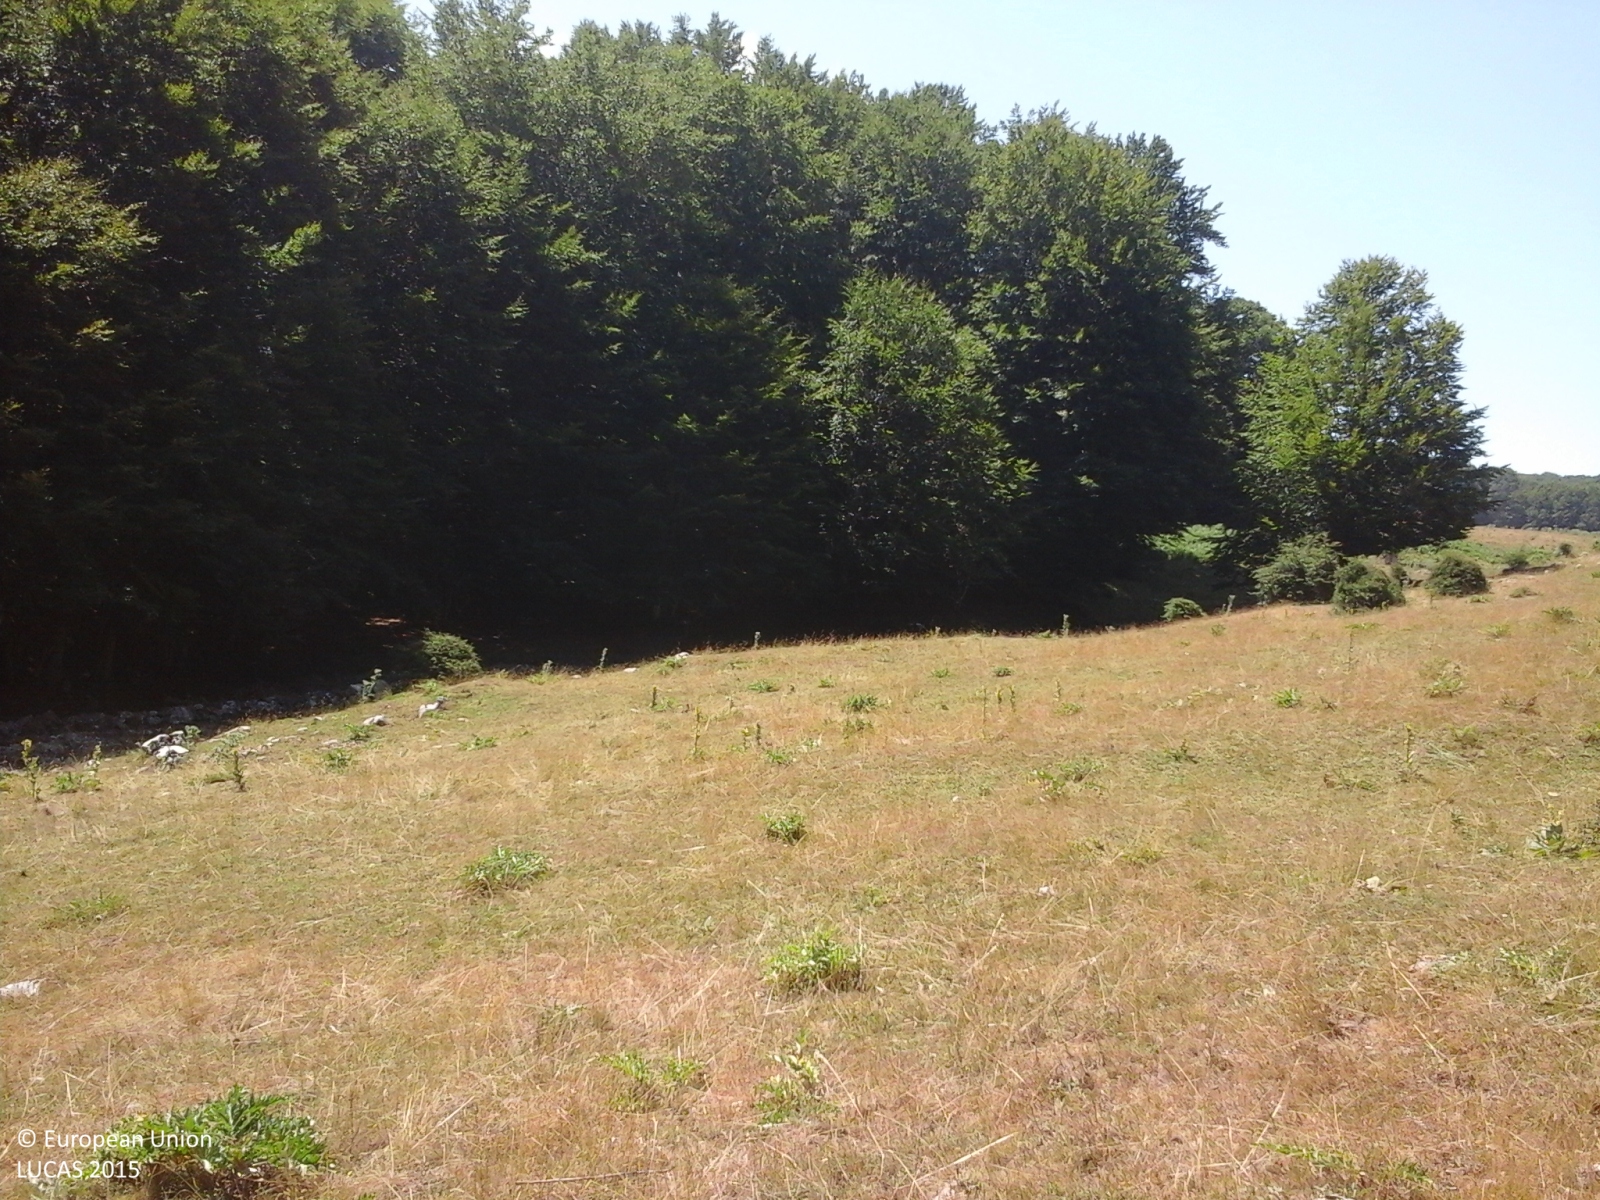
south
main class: Grassland
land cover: Grassland without tree/shrub cover
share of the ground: > 75 %
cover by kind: herbaceous plants 100 %
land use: Agriculture (excluding fallow land and kitchen gardens)
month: July
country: IT
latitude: 40.7867
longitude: 15.1109
